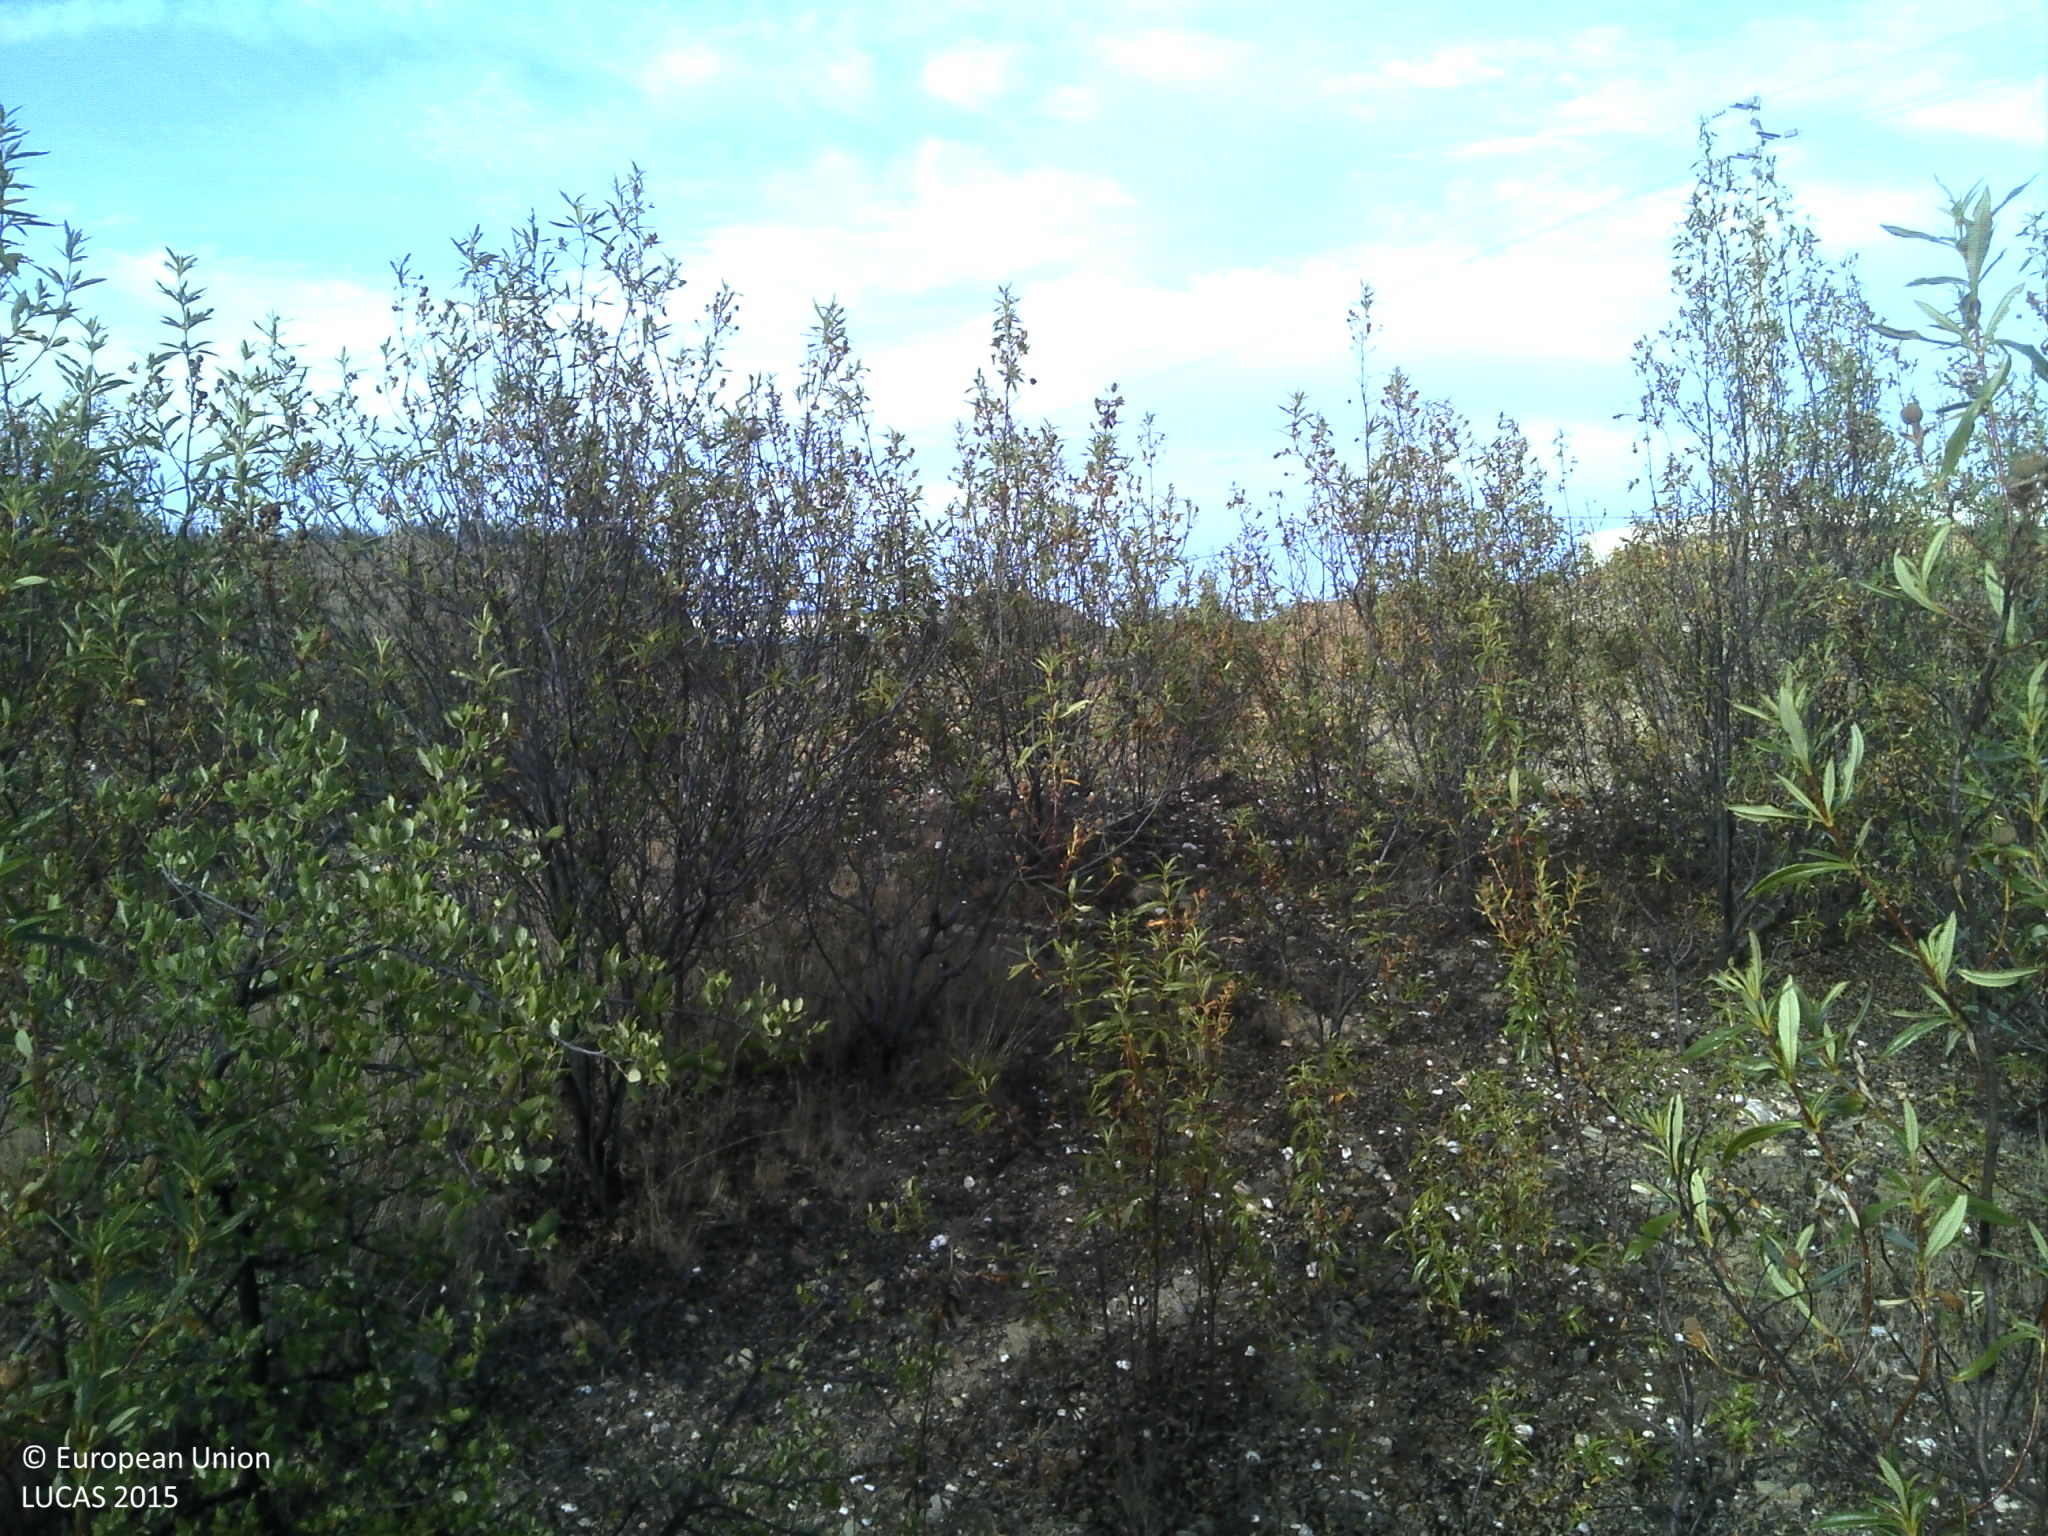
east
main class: Shrubland
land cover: Shrubland without tree cover
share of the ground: 25 - 50 %
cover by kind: shrubs 50 %, unconsolidated bare surface 50 %
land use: Construction
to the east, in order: Shrubland without tree cover; Artificial constructions in urban areas
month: July
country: PT
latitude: 39.8000
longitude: -7.5368
